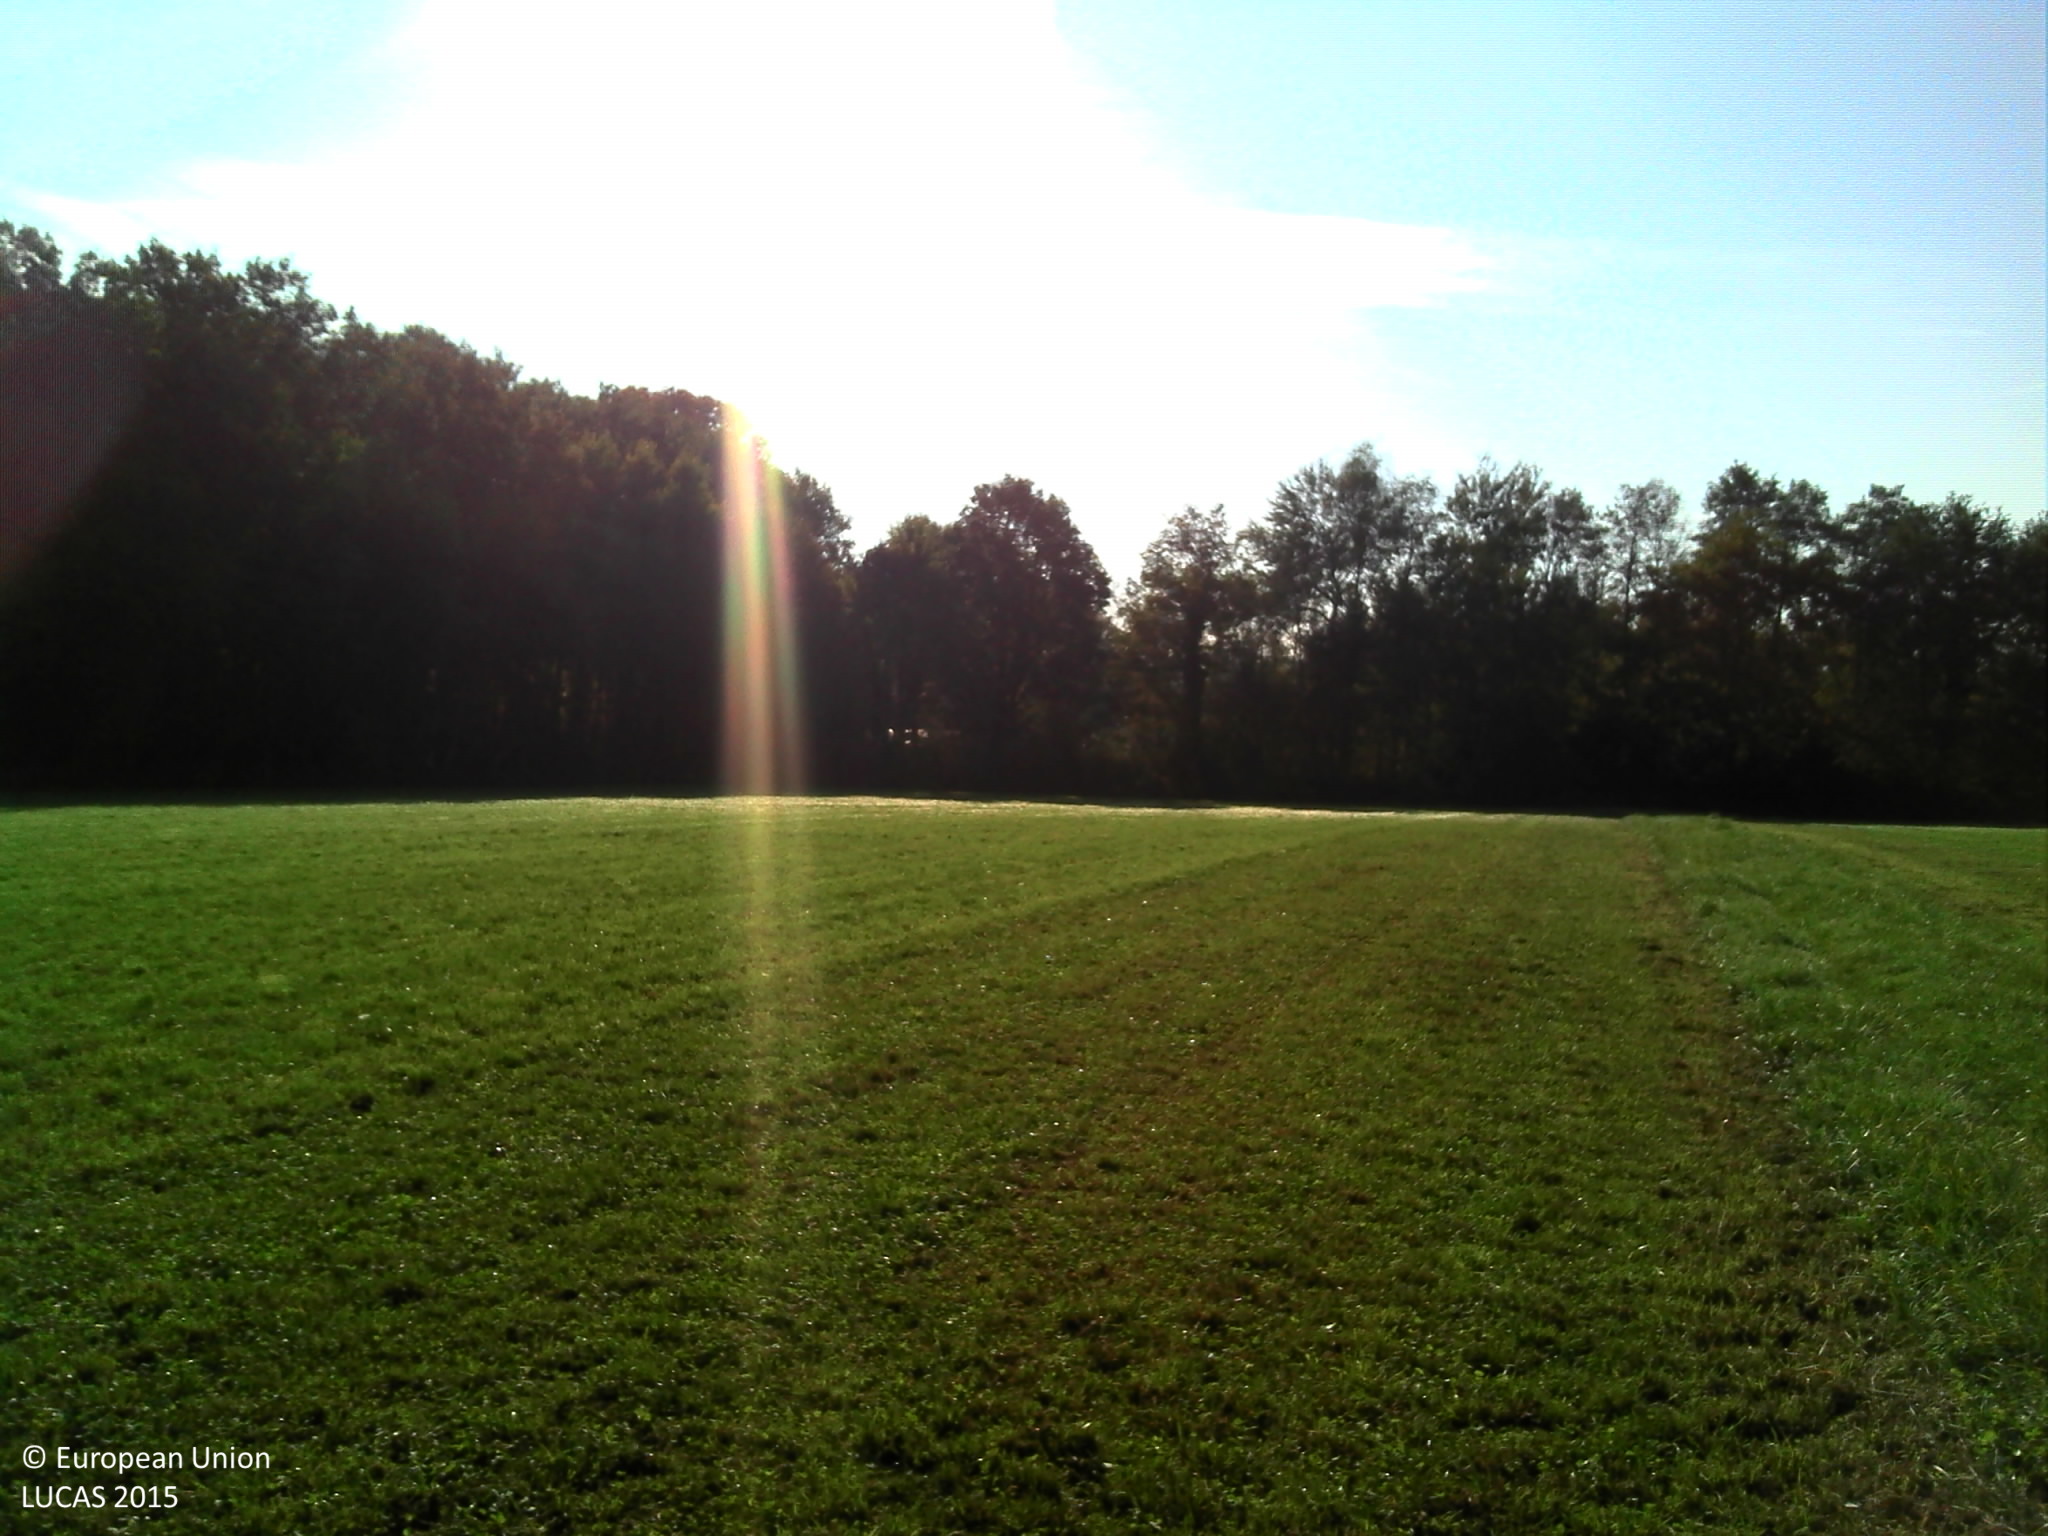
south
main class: Cropland
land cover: Temporary grasslands
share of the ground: > 75 %
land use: Agriculture (excluding fallow land and kitchen gardens)
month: October
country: FR
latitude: 46.0668
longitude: 5.2846
